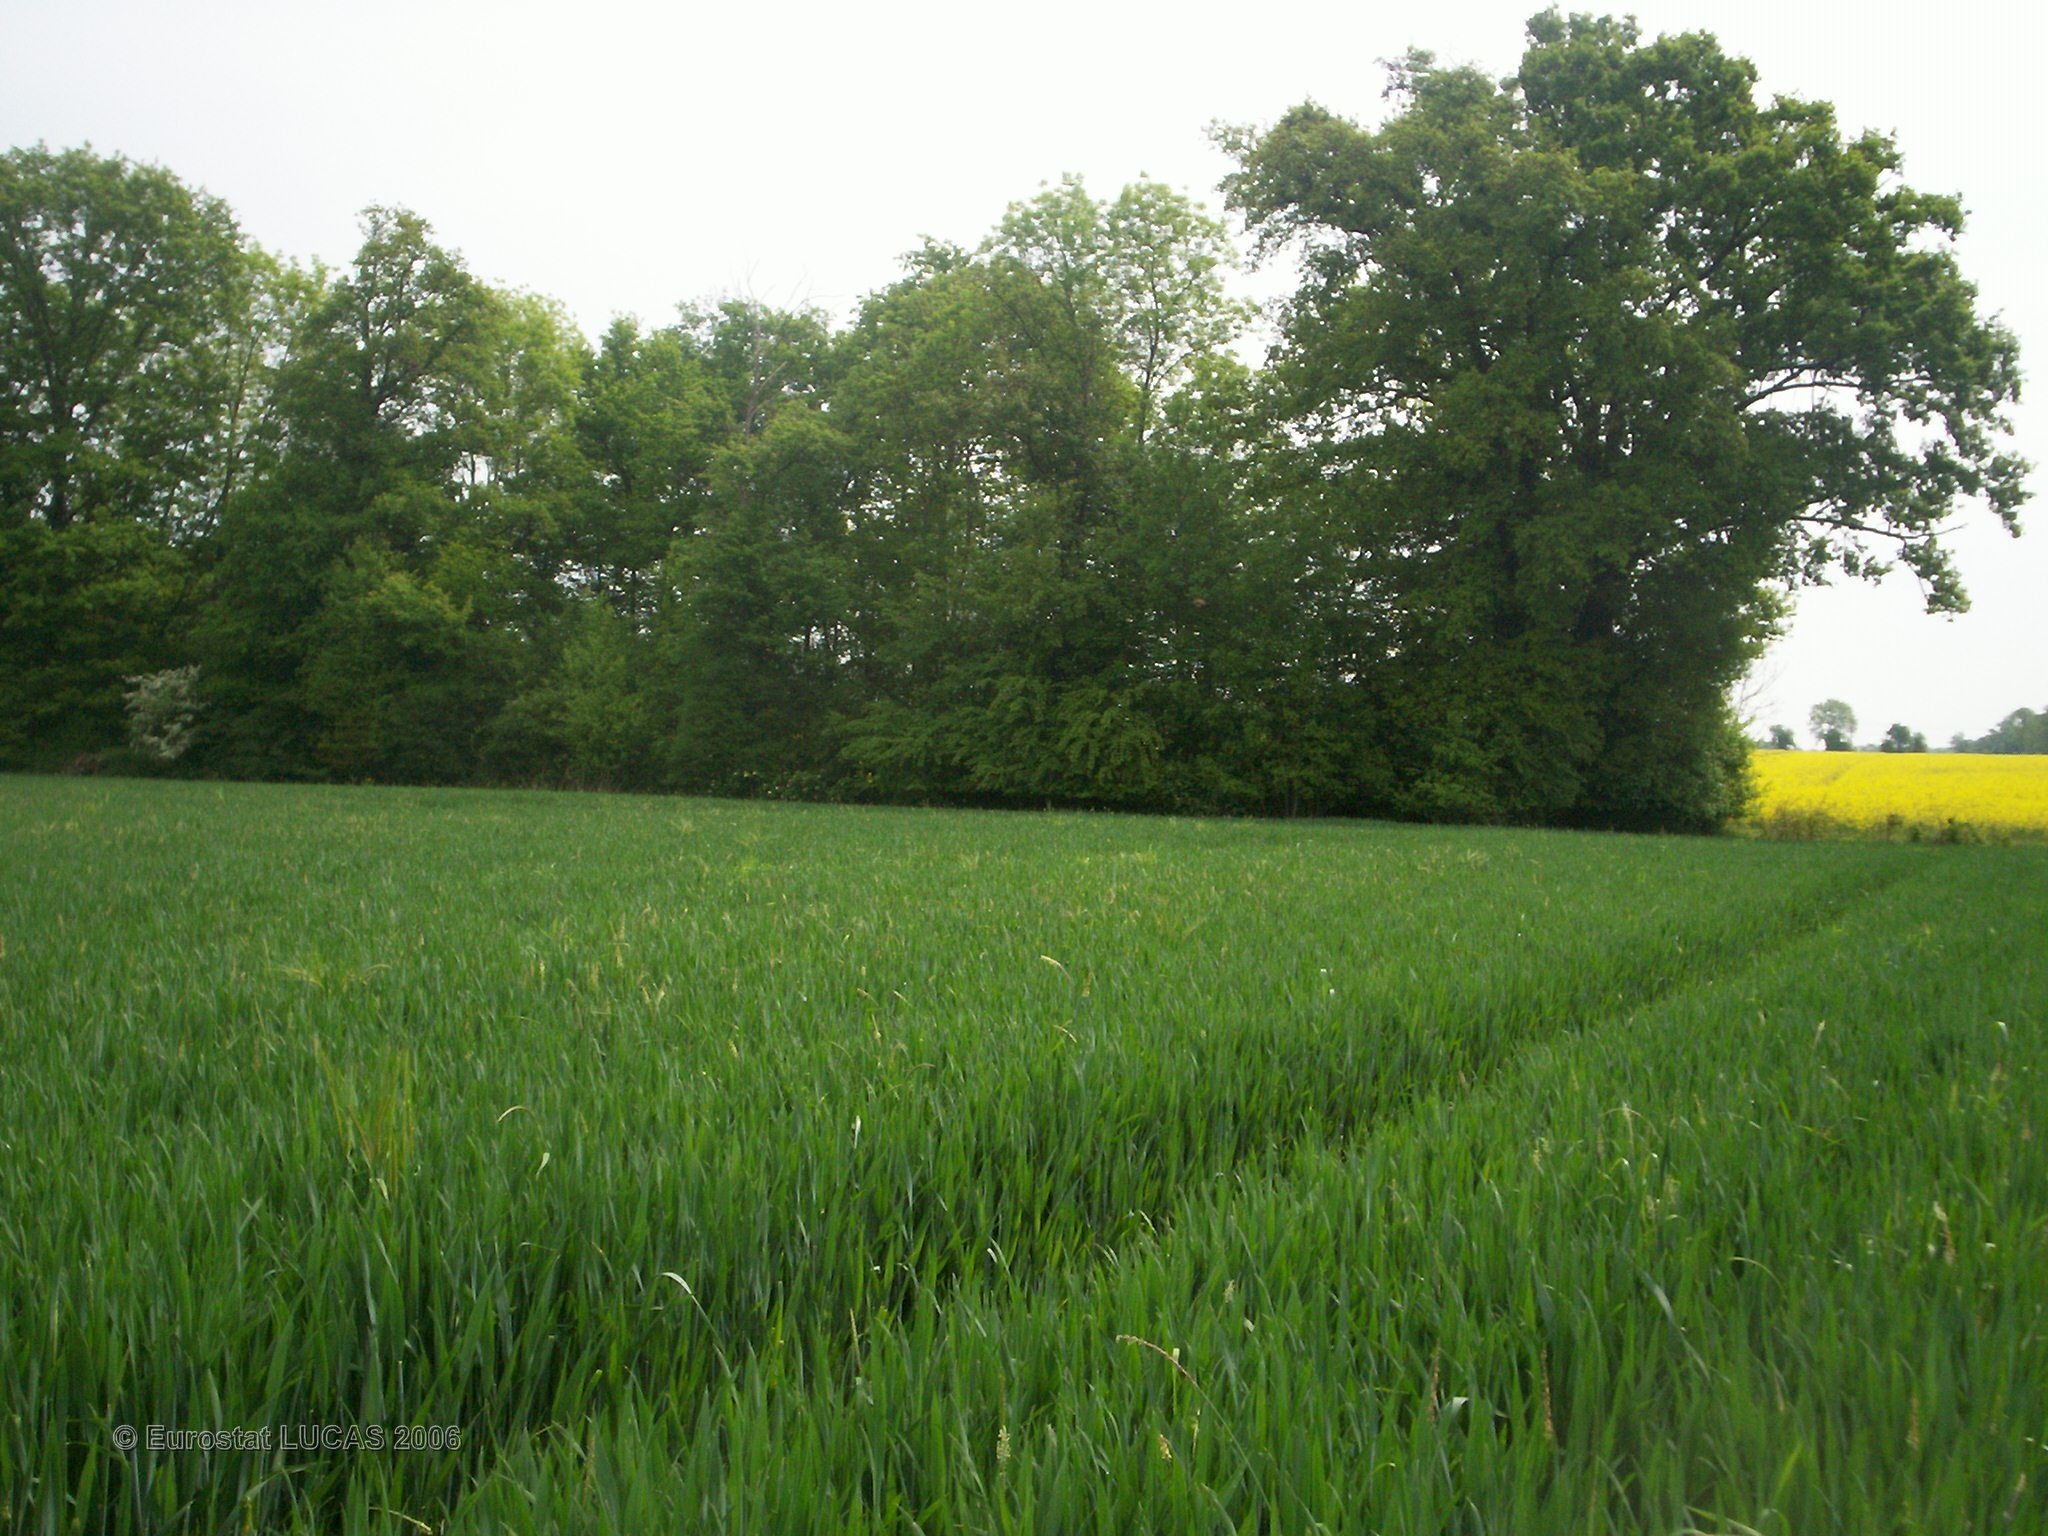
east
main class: Cropland
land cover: Common wheat
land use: Agriculture (excluding fallow land and kitchen gardens)
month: May
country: FR
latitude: 47.7637
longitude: 2.9622
